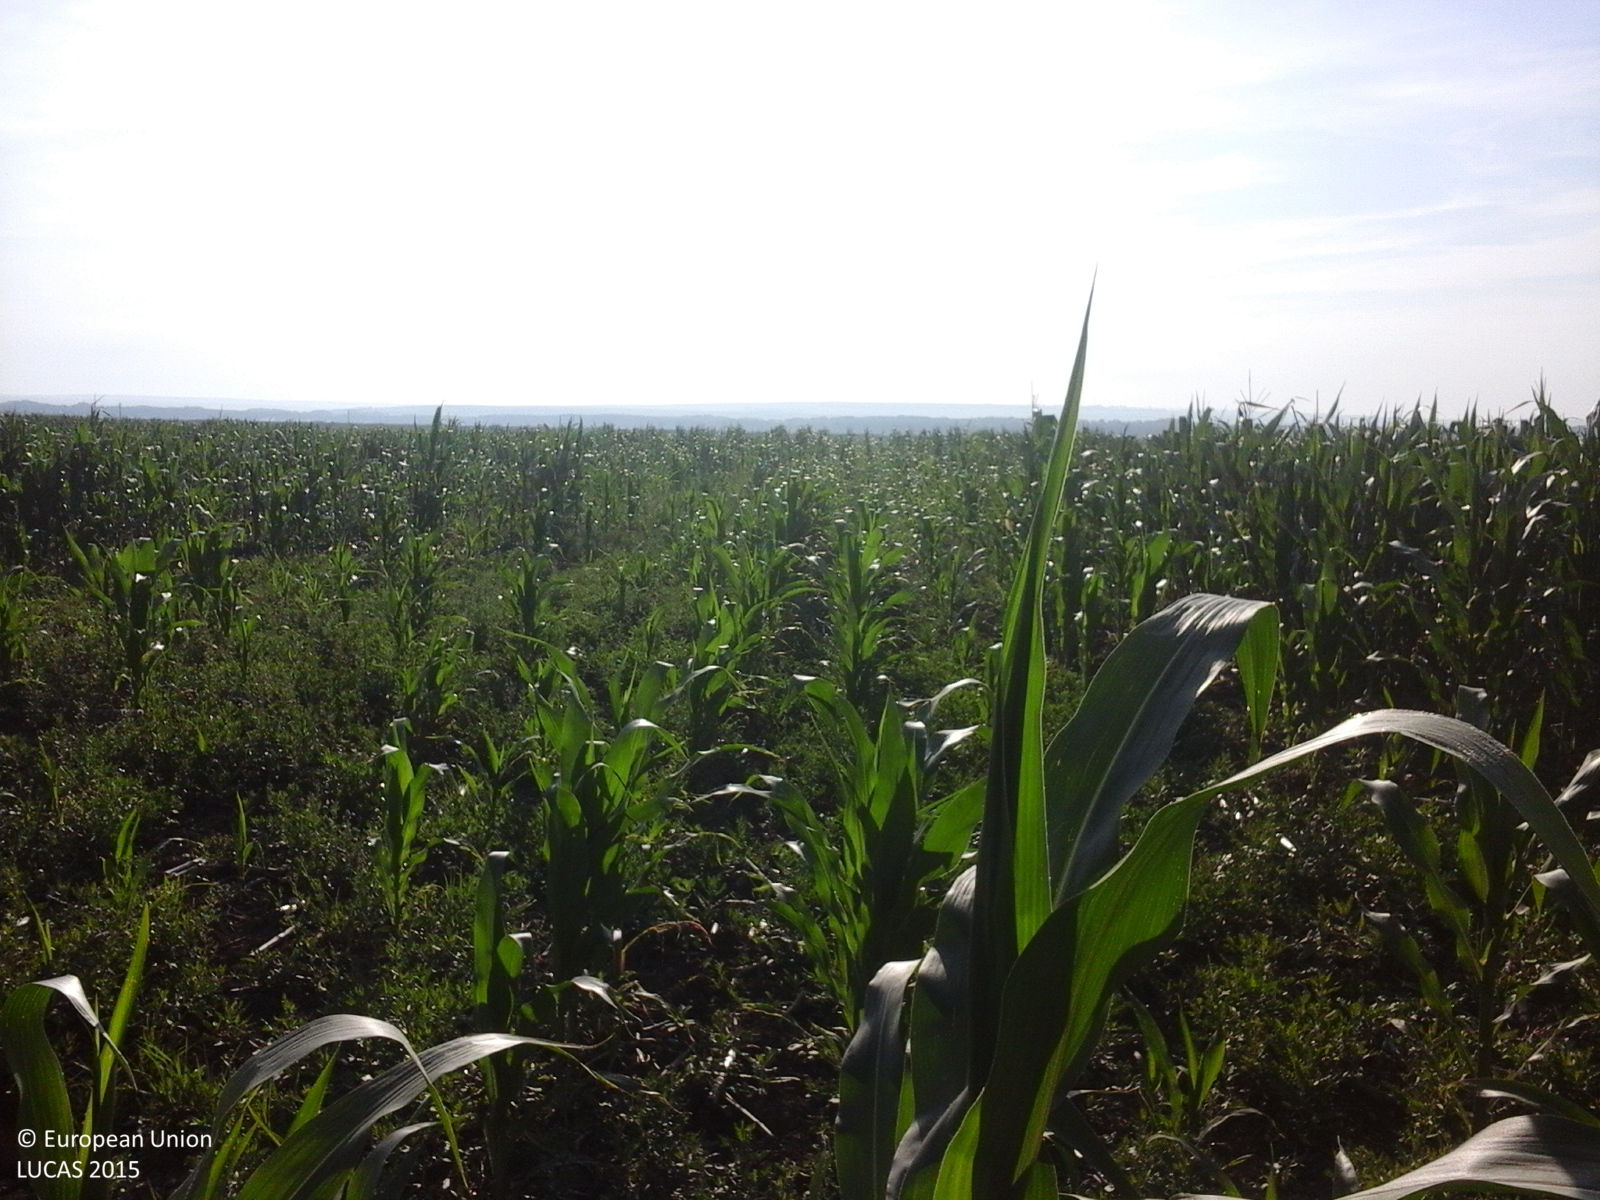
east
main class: Cropland
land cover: Maize
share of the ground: 50 - 75 %
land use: Agriculture (excluding fallow land and kitchen gardens)
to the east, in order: Maize
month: July
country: RO
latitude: 46.5096
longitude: 28.1825
